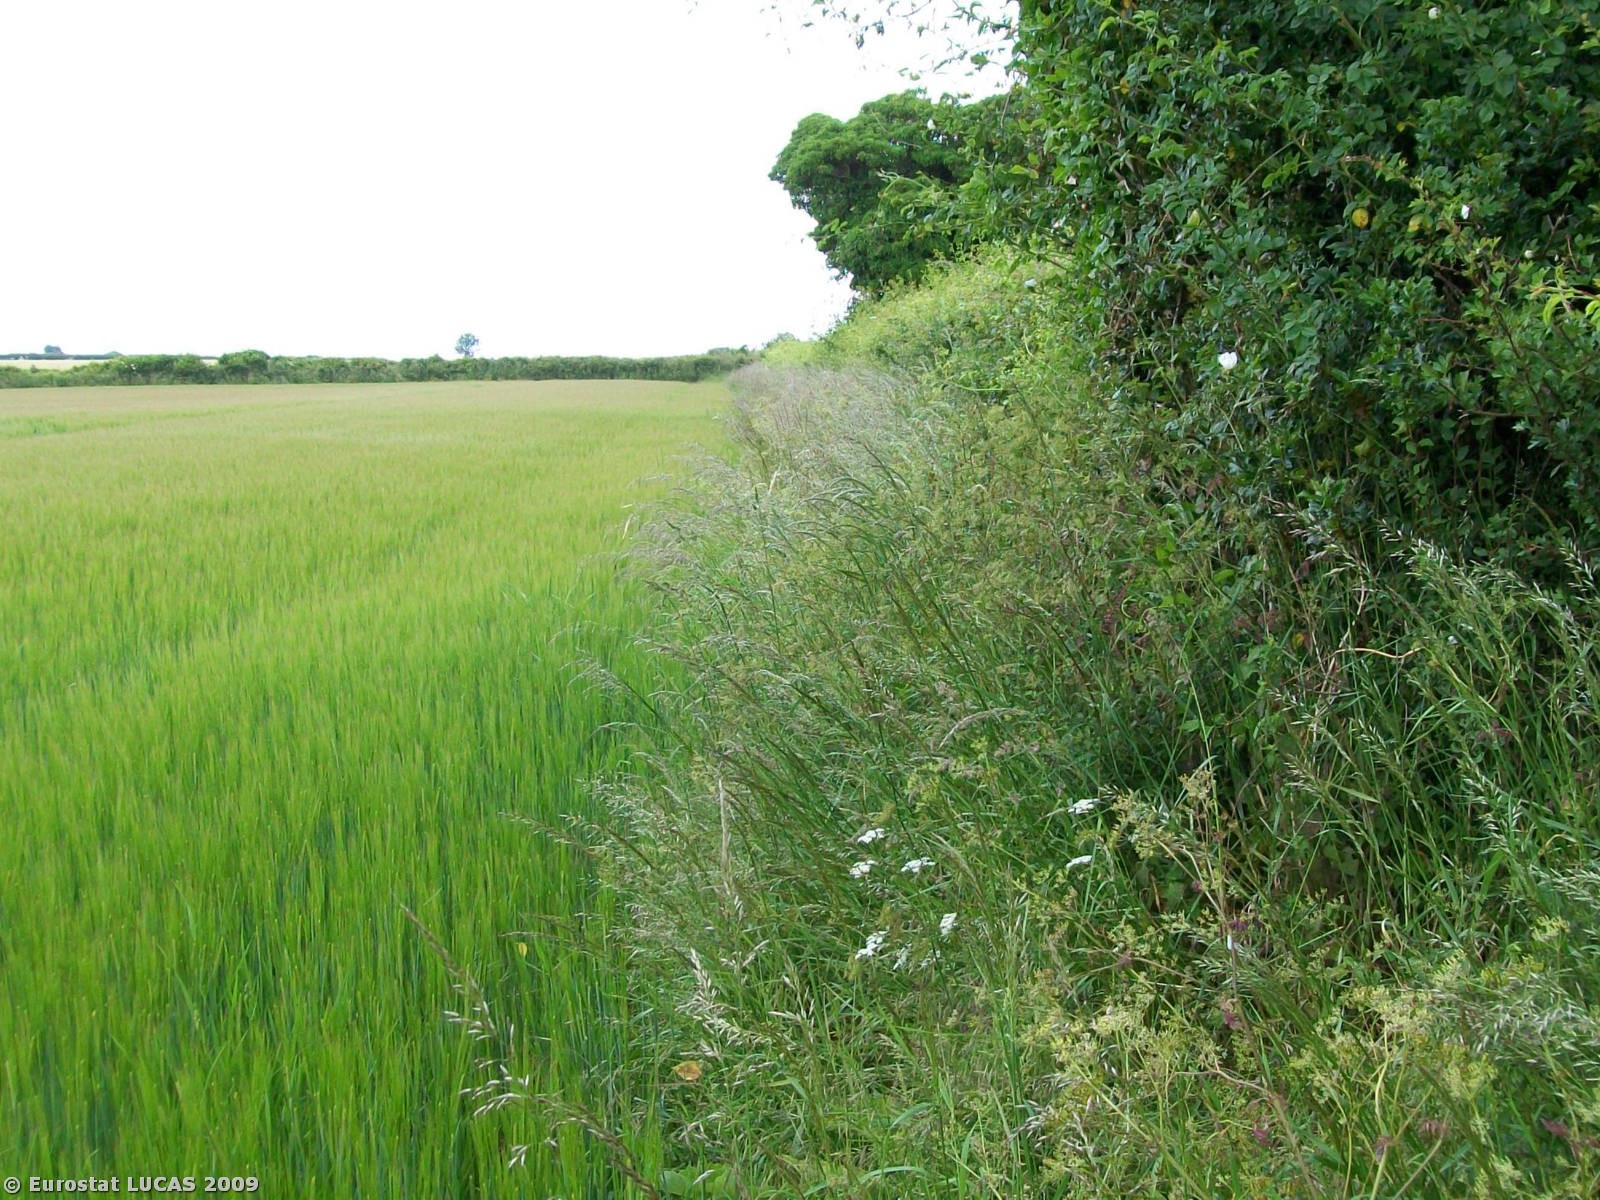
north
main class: Cropland
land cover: Barley
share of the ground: > 75 %
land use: Agriculture (excluding fallow land and kitchen gardens)
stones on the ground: 10 - 25 %
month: June
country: GB
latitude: 50.8652
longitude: -2.0943
